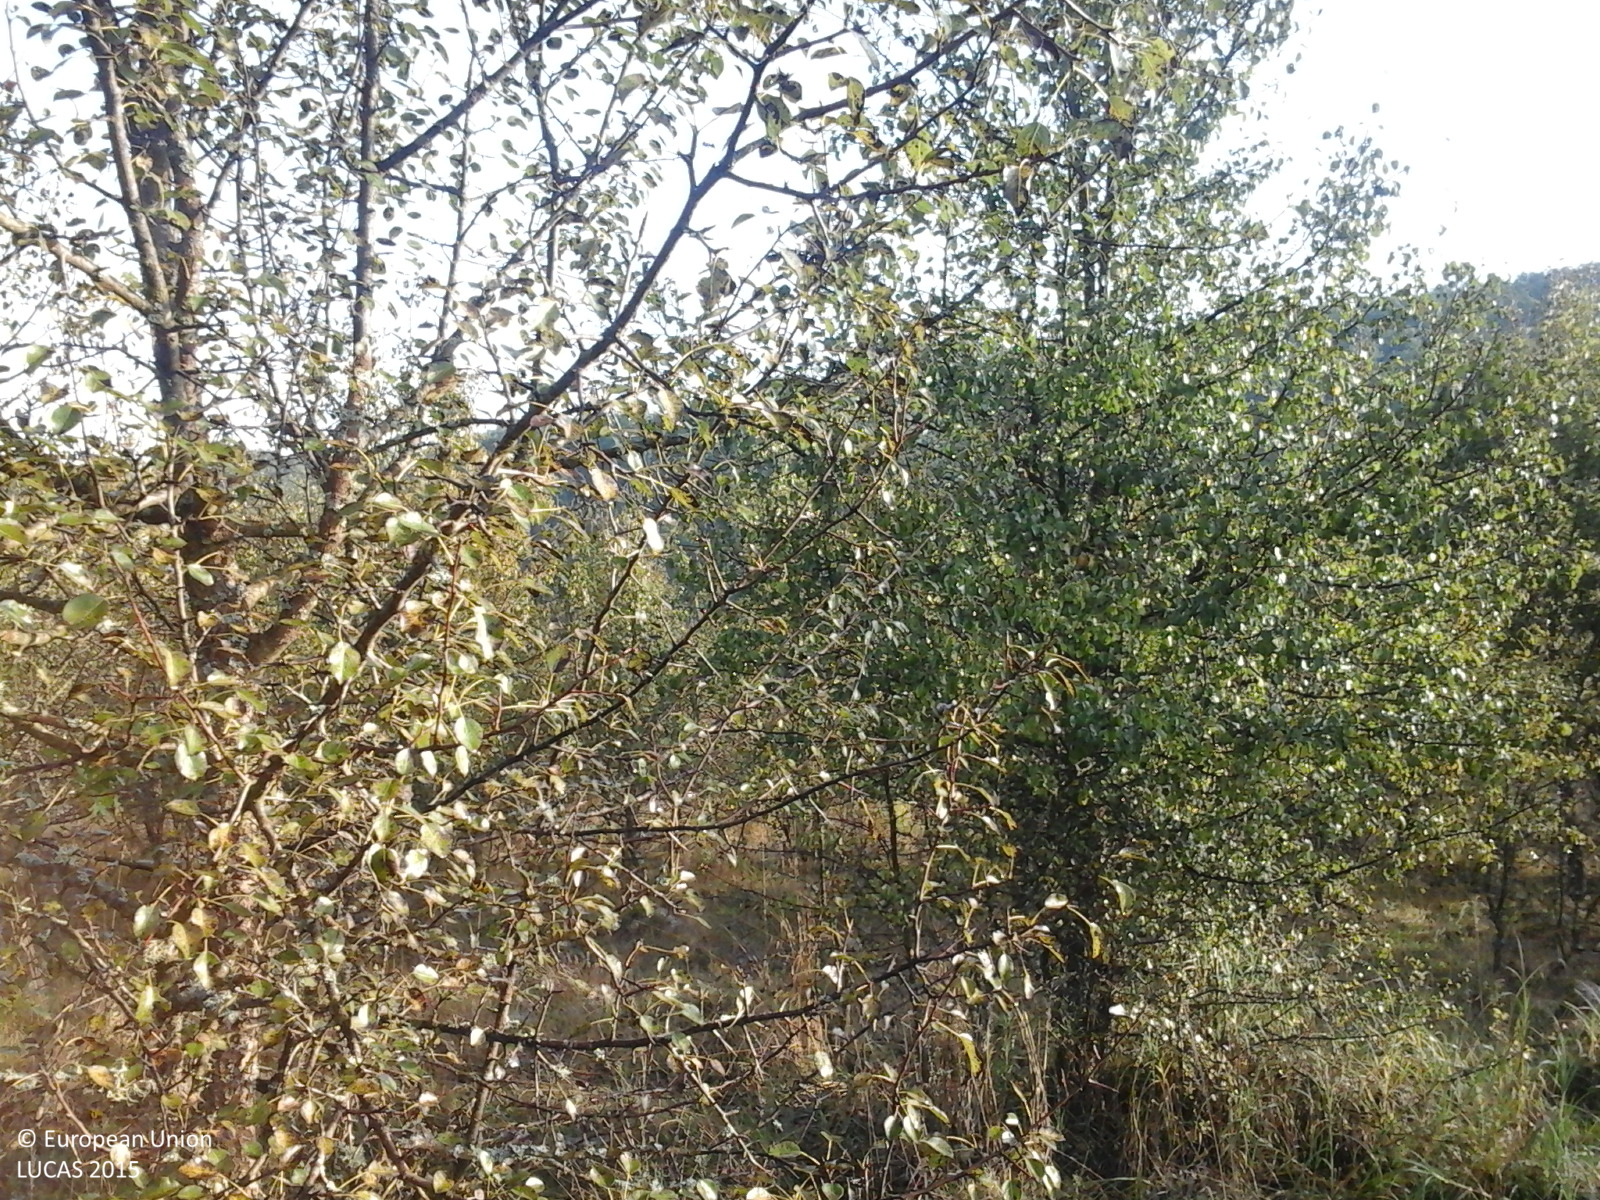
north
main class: Grassland
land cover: Grassland with sparse tree/shrub cover
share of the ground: > 75 %
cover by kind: herbaceous plants 85 %, shrubs 10 %, broadleaved forest trees 5 %
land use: Agriculture (excluding fallow land and kitchen gardens)
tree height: > 5 m
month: September
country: RO
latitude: 46.8947
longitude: 23.3638
